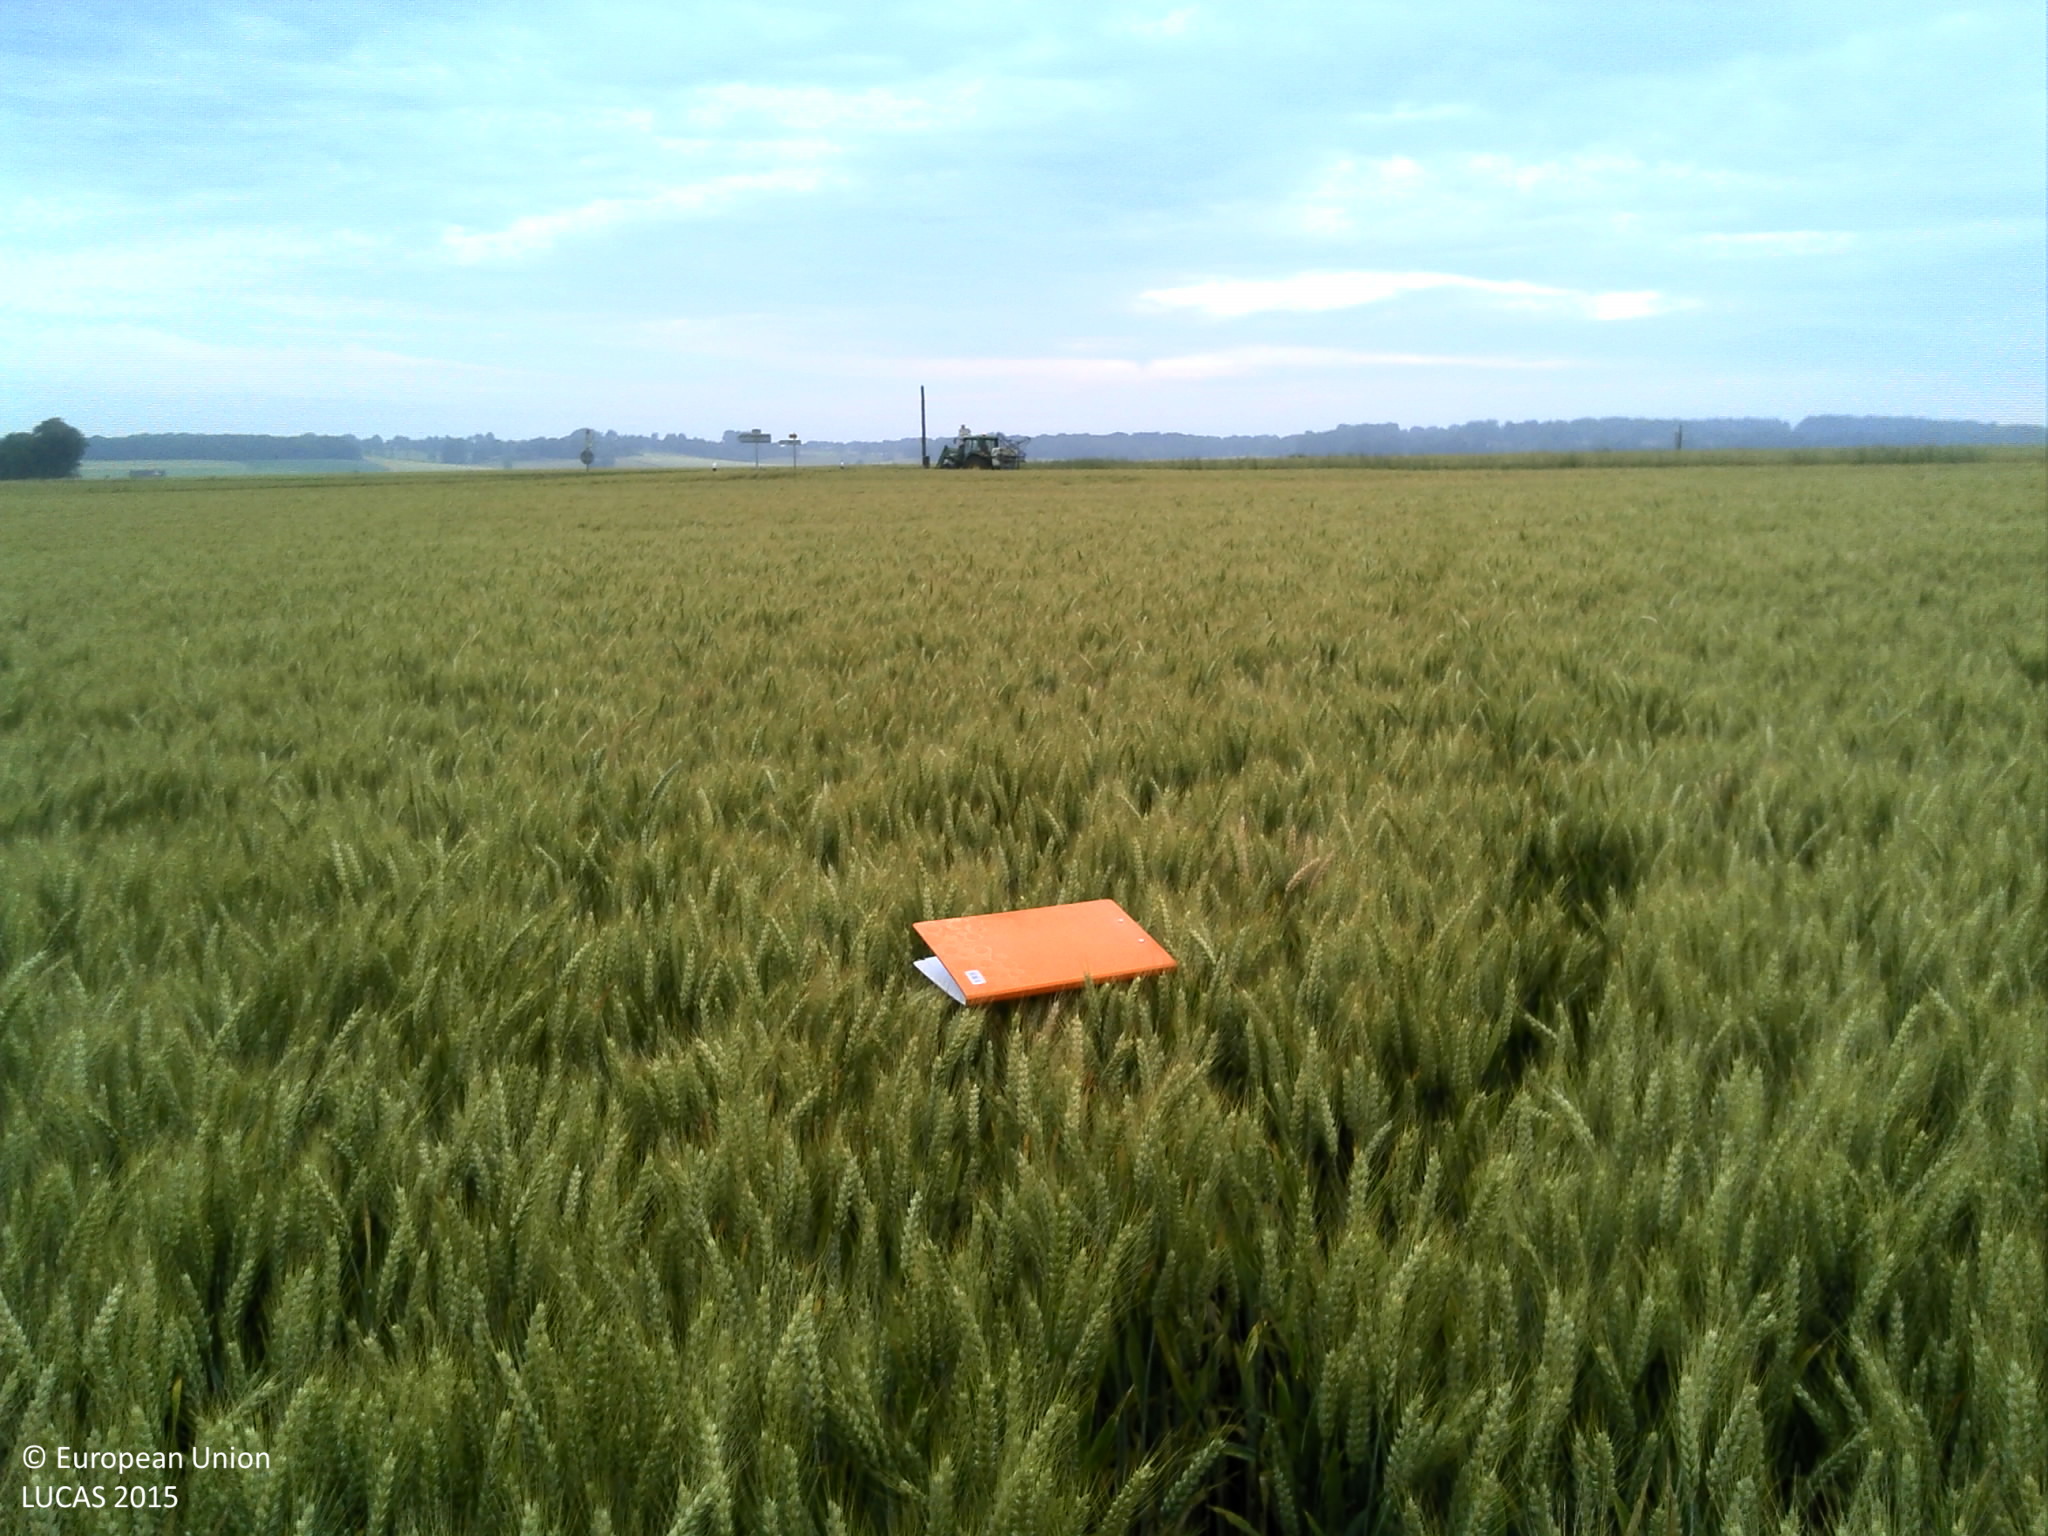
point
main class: Cropland
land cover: Durum wheat
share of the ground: > 75 %
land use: Agriculture (excluding fallow land and kitchen gardens)
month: July
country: FR
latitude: 49.8799
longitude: 0.9732
